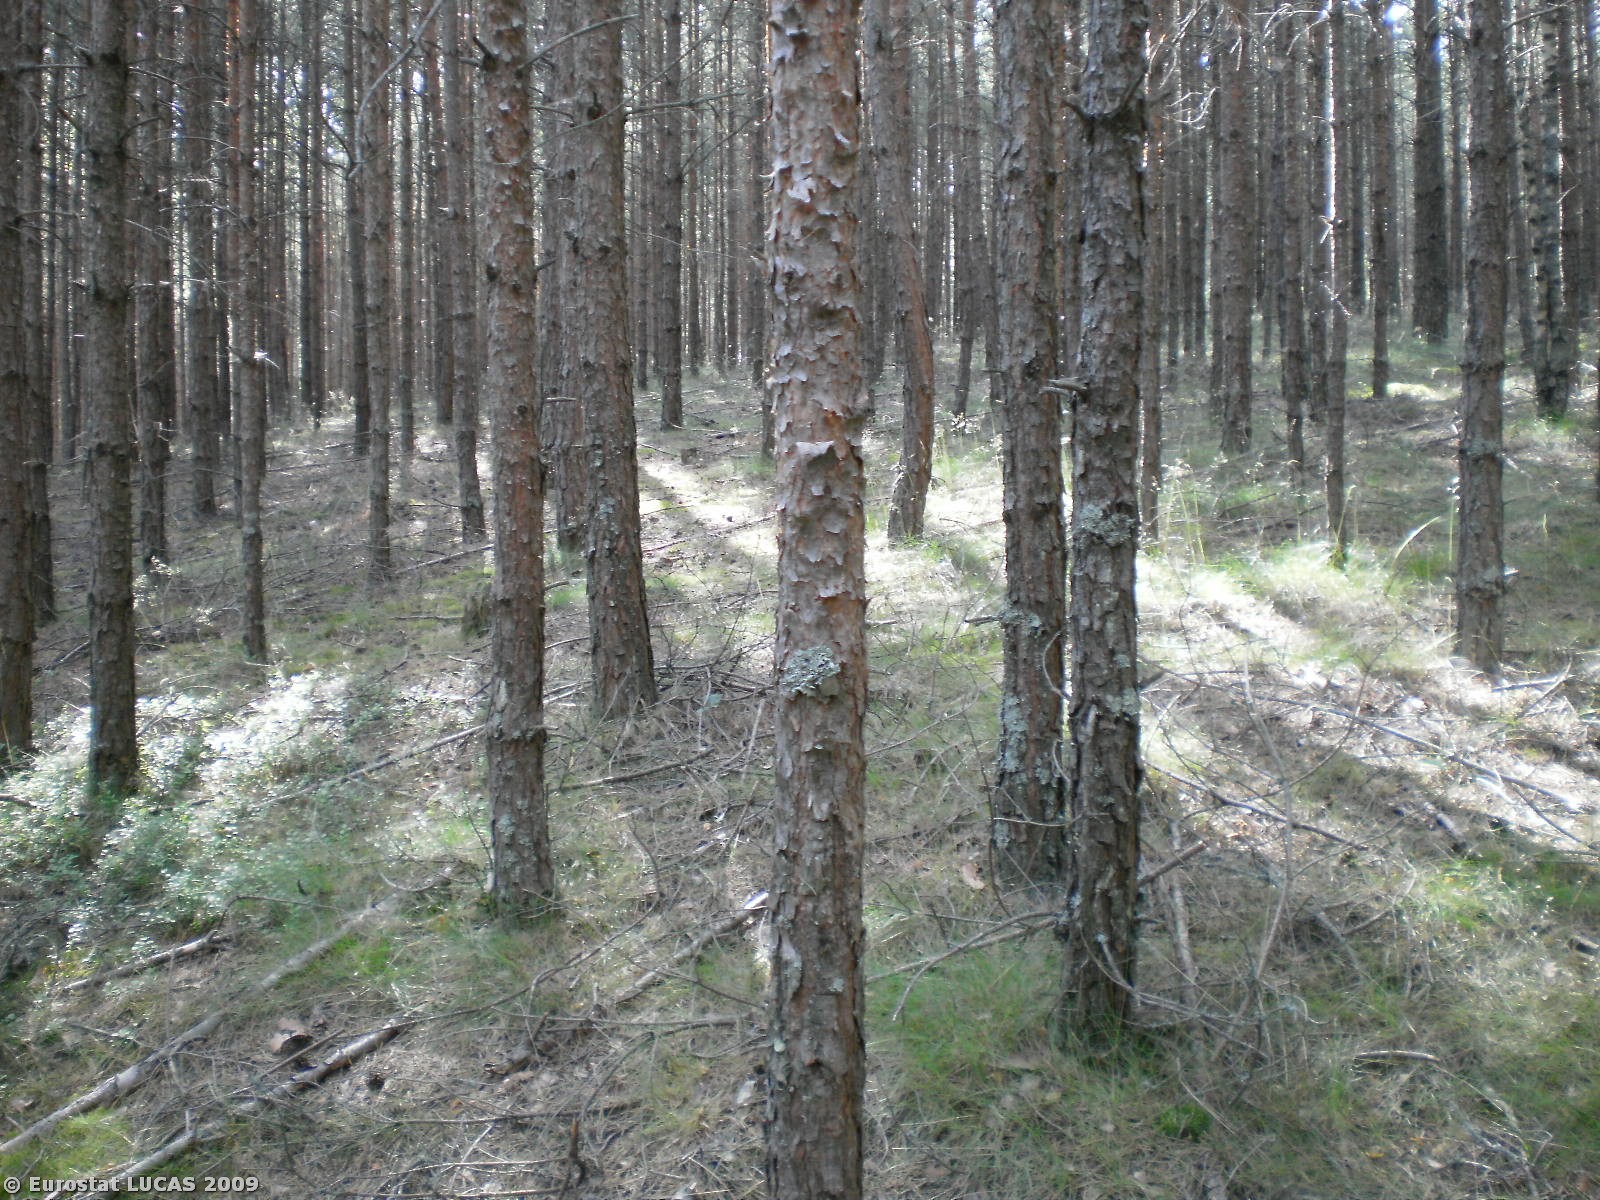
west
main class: Woodland
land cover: Coniferous woodland
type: hemiboreal forest and nemoral coniferous forest and mixed broadleaved-coniferous forest
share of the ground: > 75 %
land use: Forestry
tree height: > 5 m
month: July
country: PL
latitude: 54.0362
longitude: 17.7846
